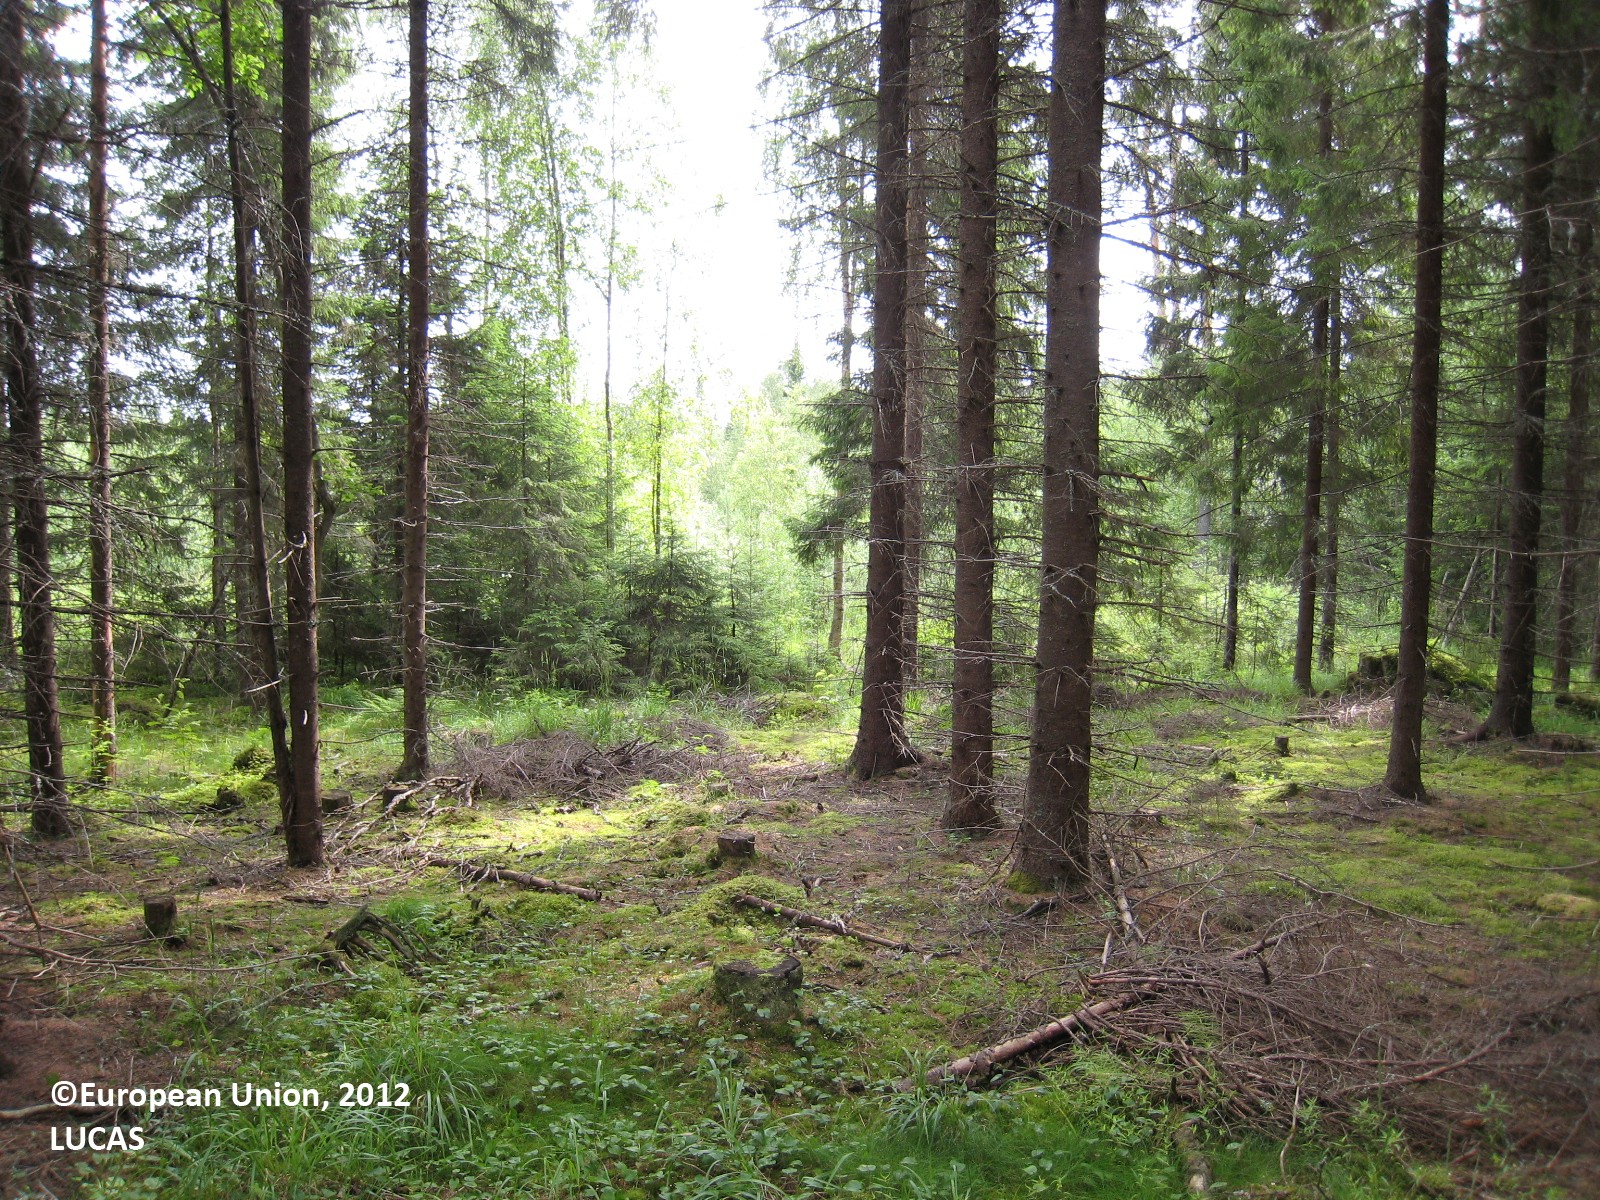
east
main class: Woodland
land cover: Spruce dominated coniferous woodland
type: boreal forest
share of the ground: 50 - 75 %
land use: Forestry
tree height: > 5 m
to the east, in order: Spruce dominated coniferous woodland; Spruce dominated mixed woodland; Ditches and canals; Spruce dominated mixed woodland; Spruce dominated coniferous woodland; Spruce dominated mixed woodland
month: July
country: FI
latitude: 61.8721
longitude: 27.1815
